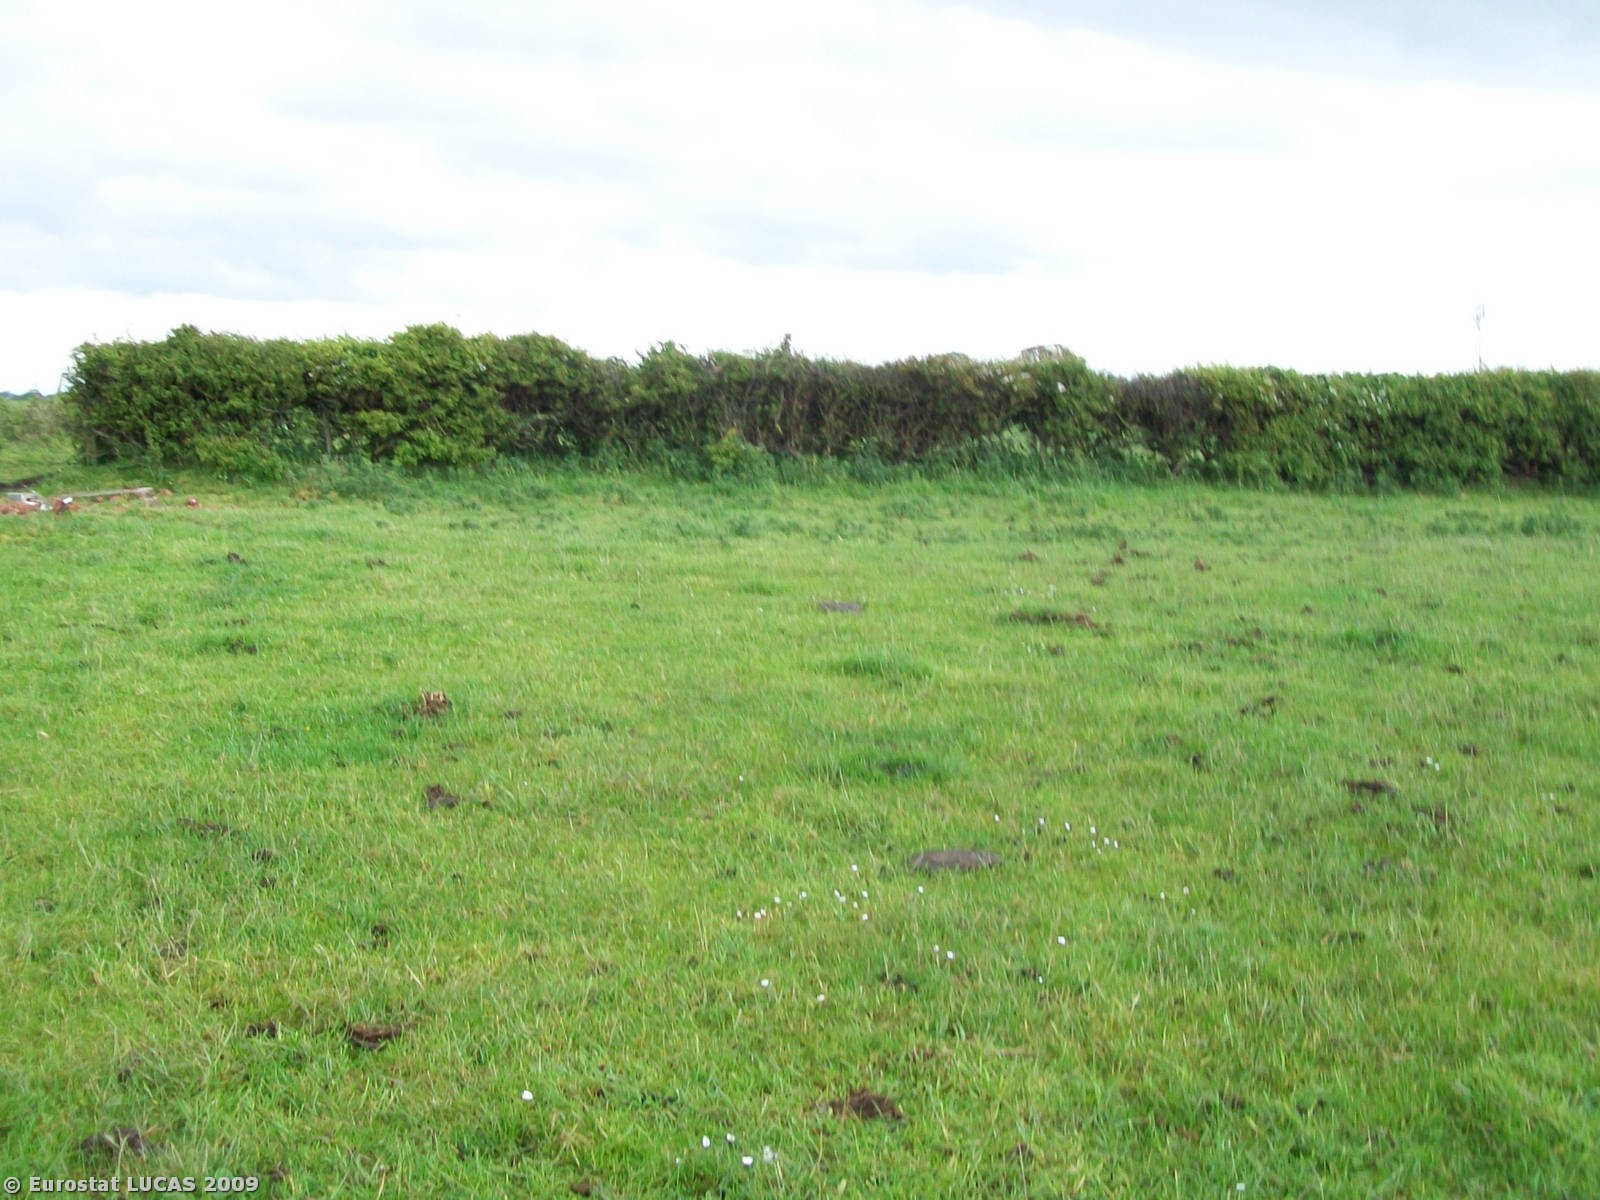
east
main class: Grassland
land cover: Grassland without tree/shrub cover
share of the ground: > 75 %
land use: Agriculture (excluding fallow land and kitchen gardens)
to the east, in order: Grassland without tree/shrub cover; Managed hedges; Grassland without tree/shrub cover
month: May
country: GB
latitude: 53.8622
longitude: -3.0137
